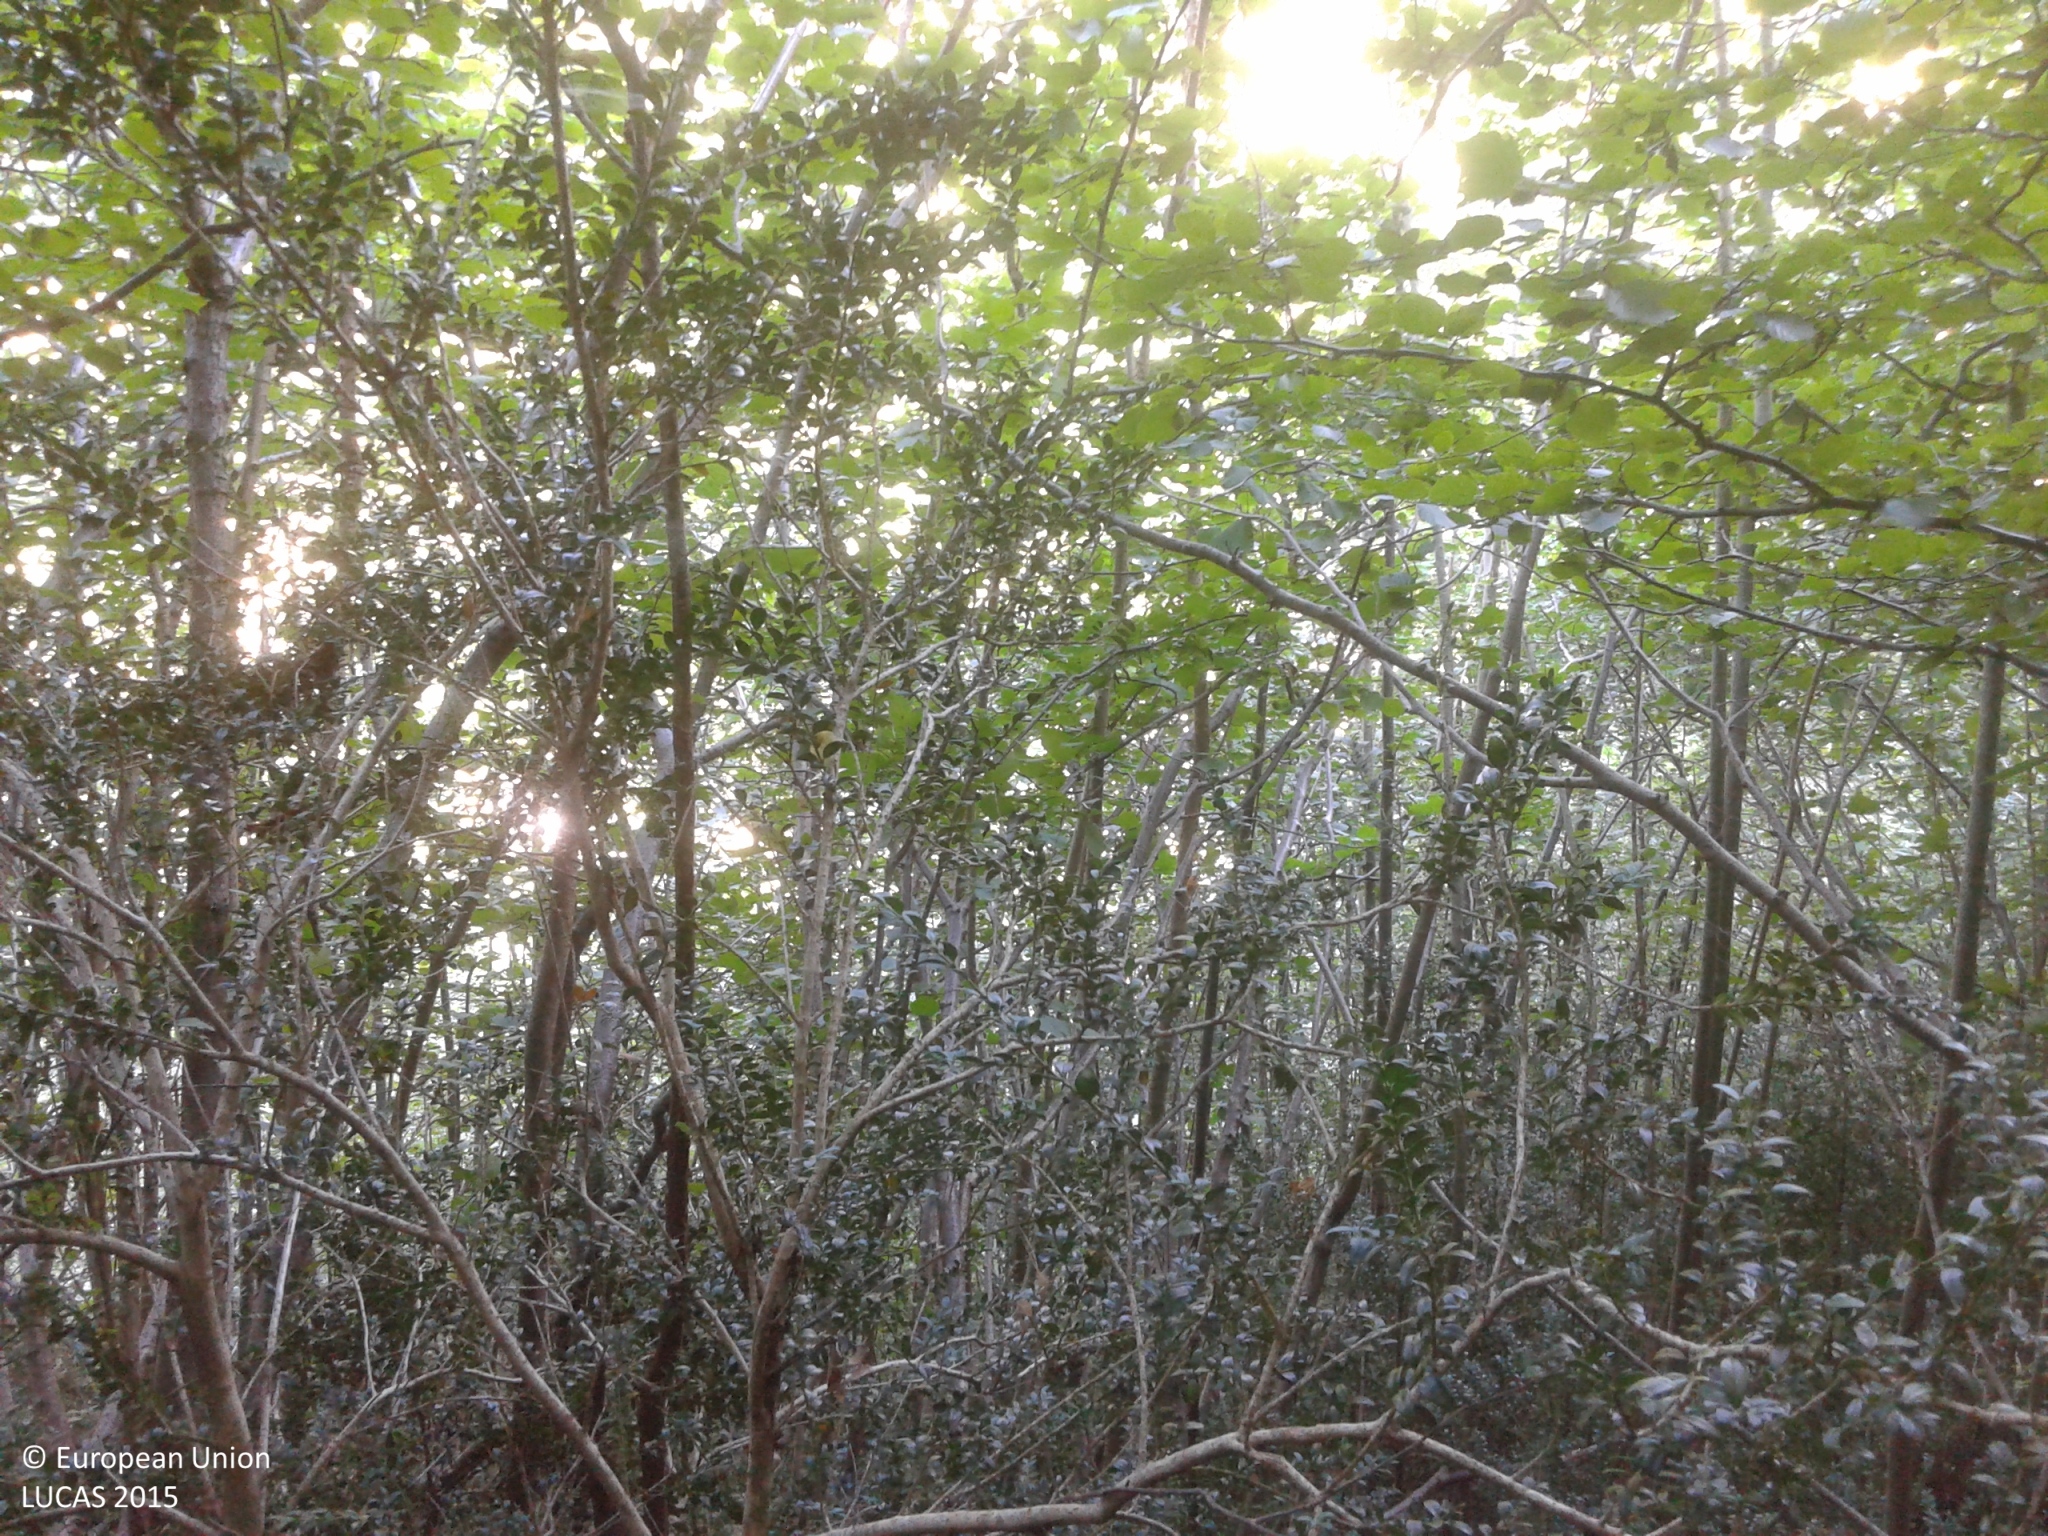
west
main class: Woodland
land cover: Broadleaved woodland
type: alpine coniferous forest
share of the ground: > 75 %
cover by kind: broadleaved forest trees 90 %, shrubs 10 %
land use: Semi-natural and natural areas not in use
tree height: > 5 m
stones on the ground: > 50 %
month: August
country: ES
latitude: 42.4701
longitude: 0.9948
